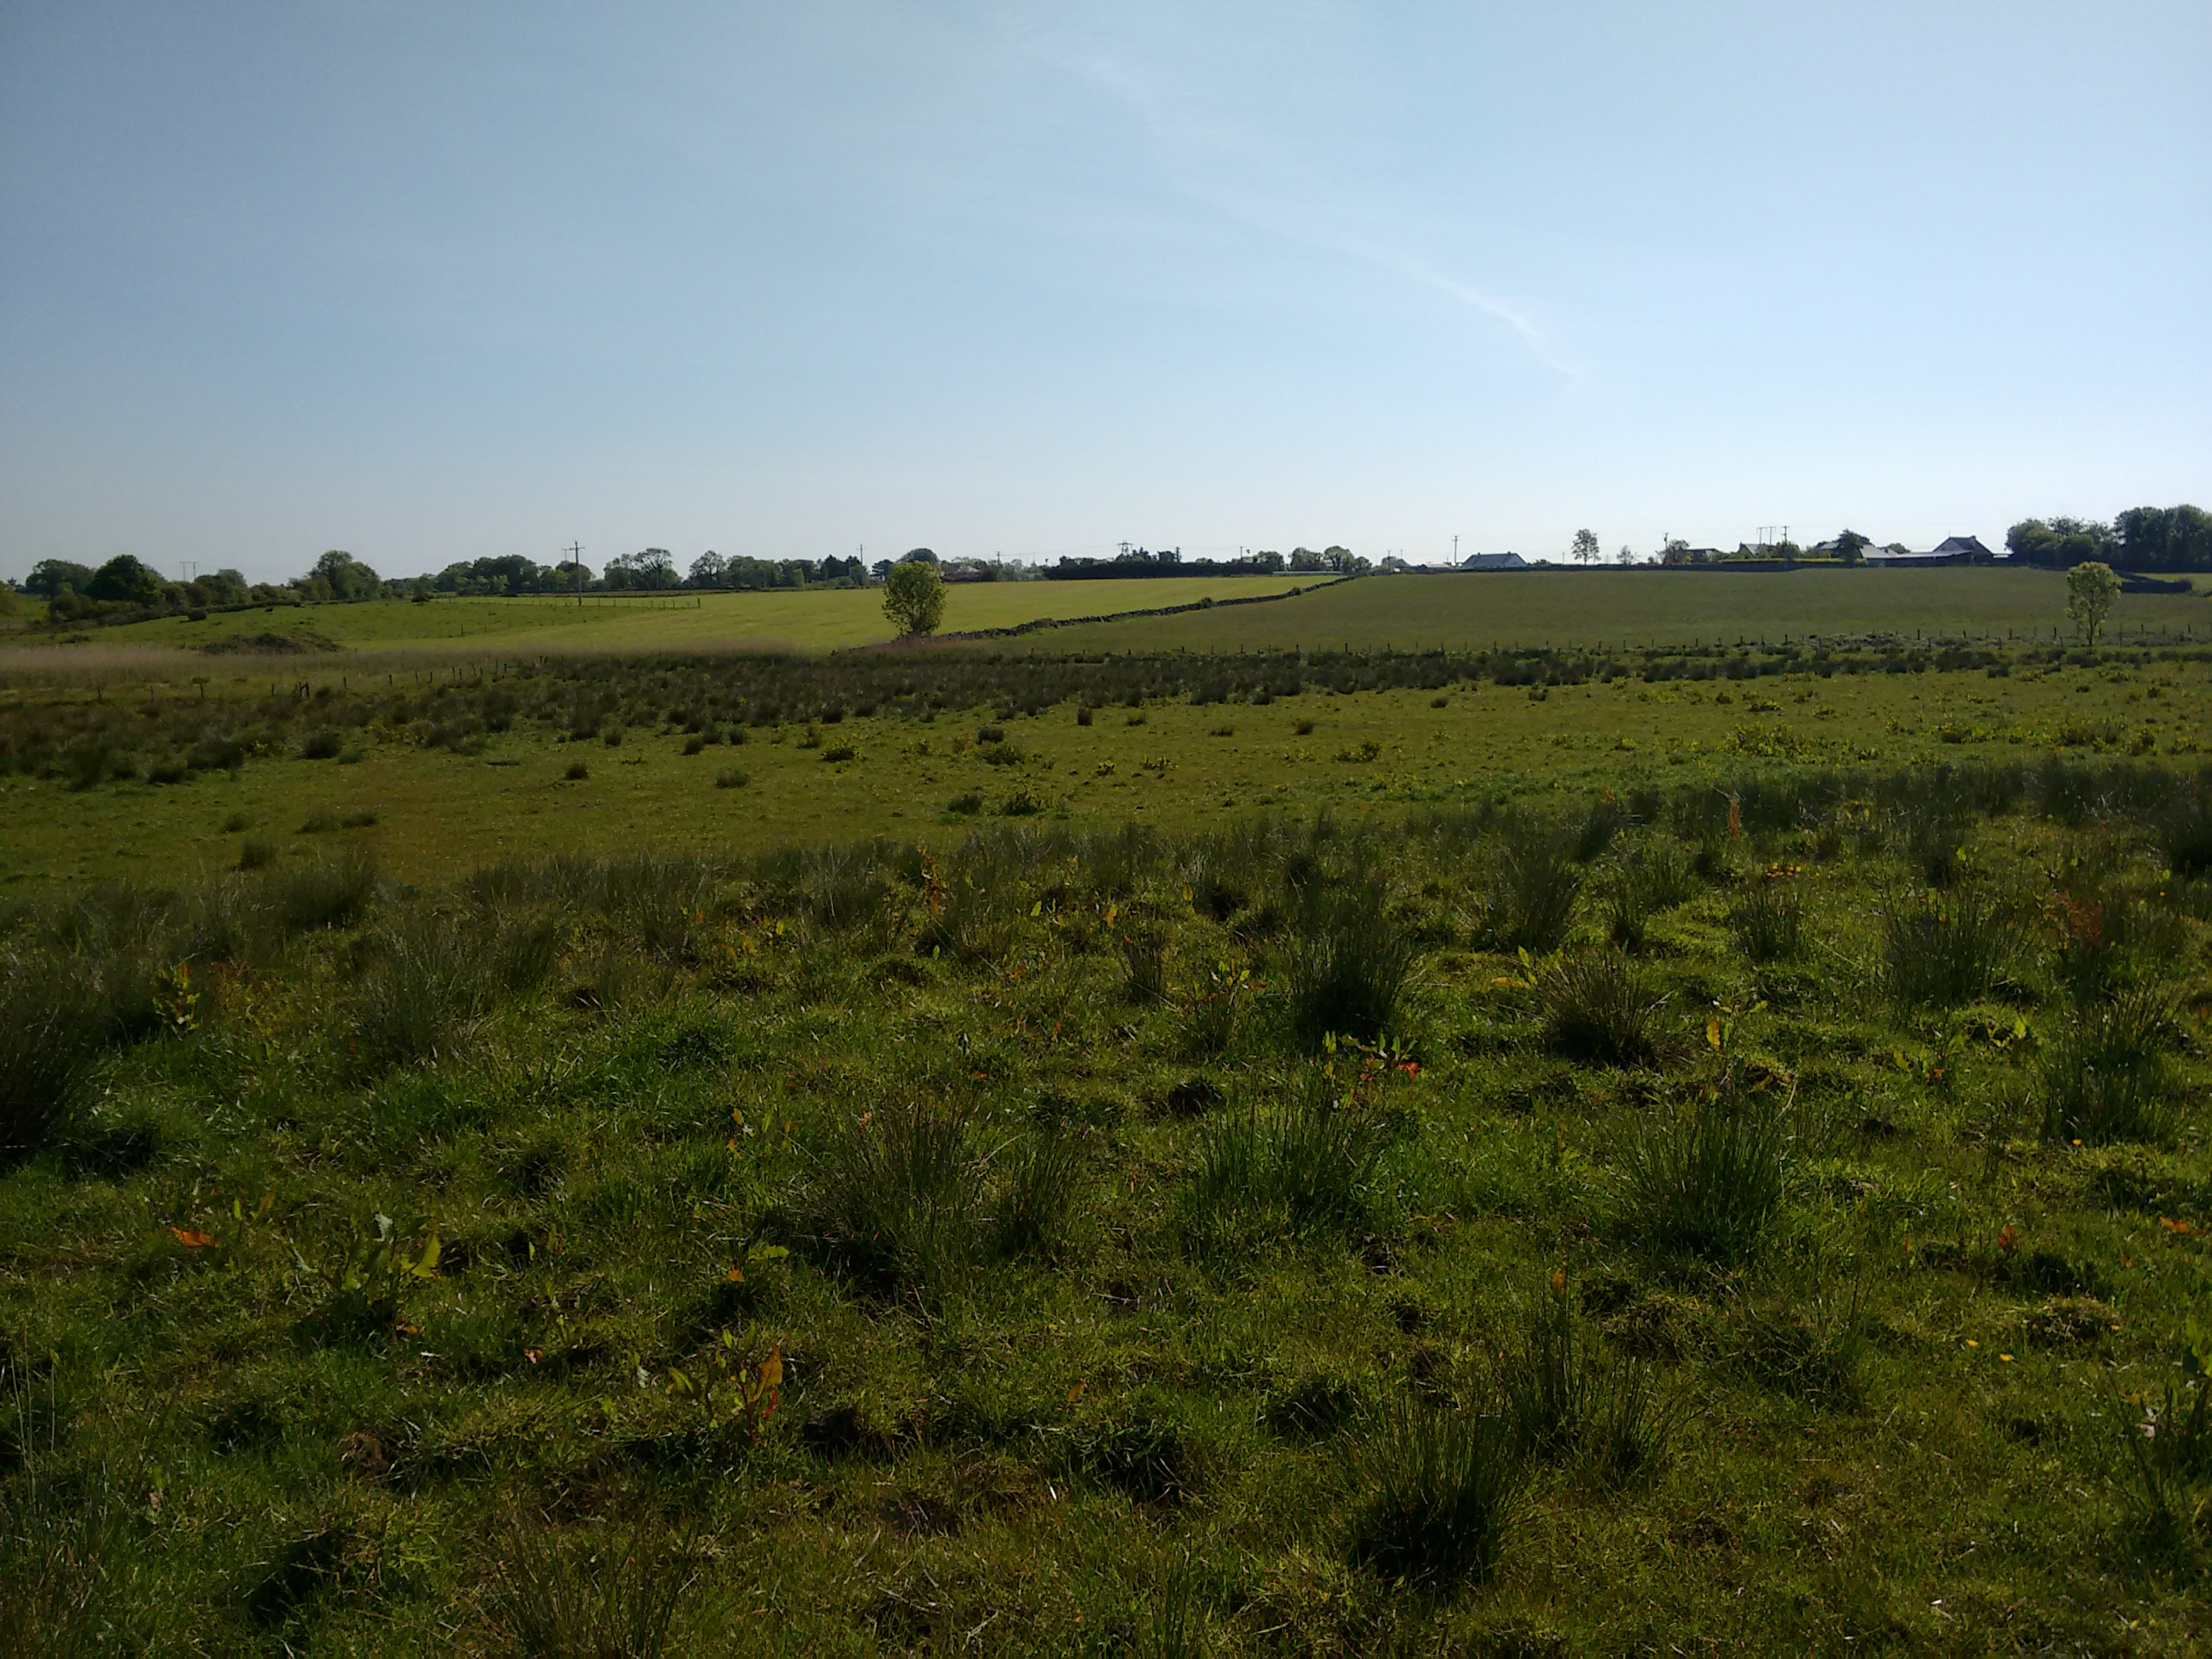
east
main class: Grassland
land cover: Grassland without tree/shrub cover
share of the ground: > 75 %
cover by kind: herbaceous plants 100 %
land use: Agriculture (excluding fallow land and kitchen gardens)
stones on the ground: < 10 %
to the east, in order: Grassland without tree/shrub cover; Fences; Ditches and canals; Fences; Grassland without tree/shrub cover
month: June
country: IE
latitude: 53.5284
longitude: -9.0878
